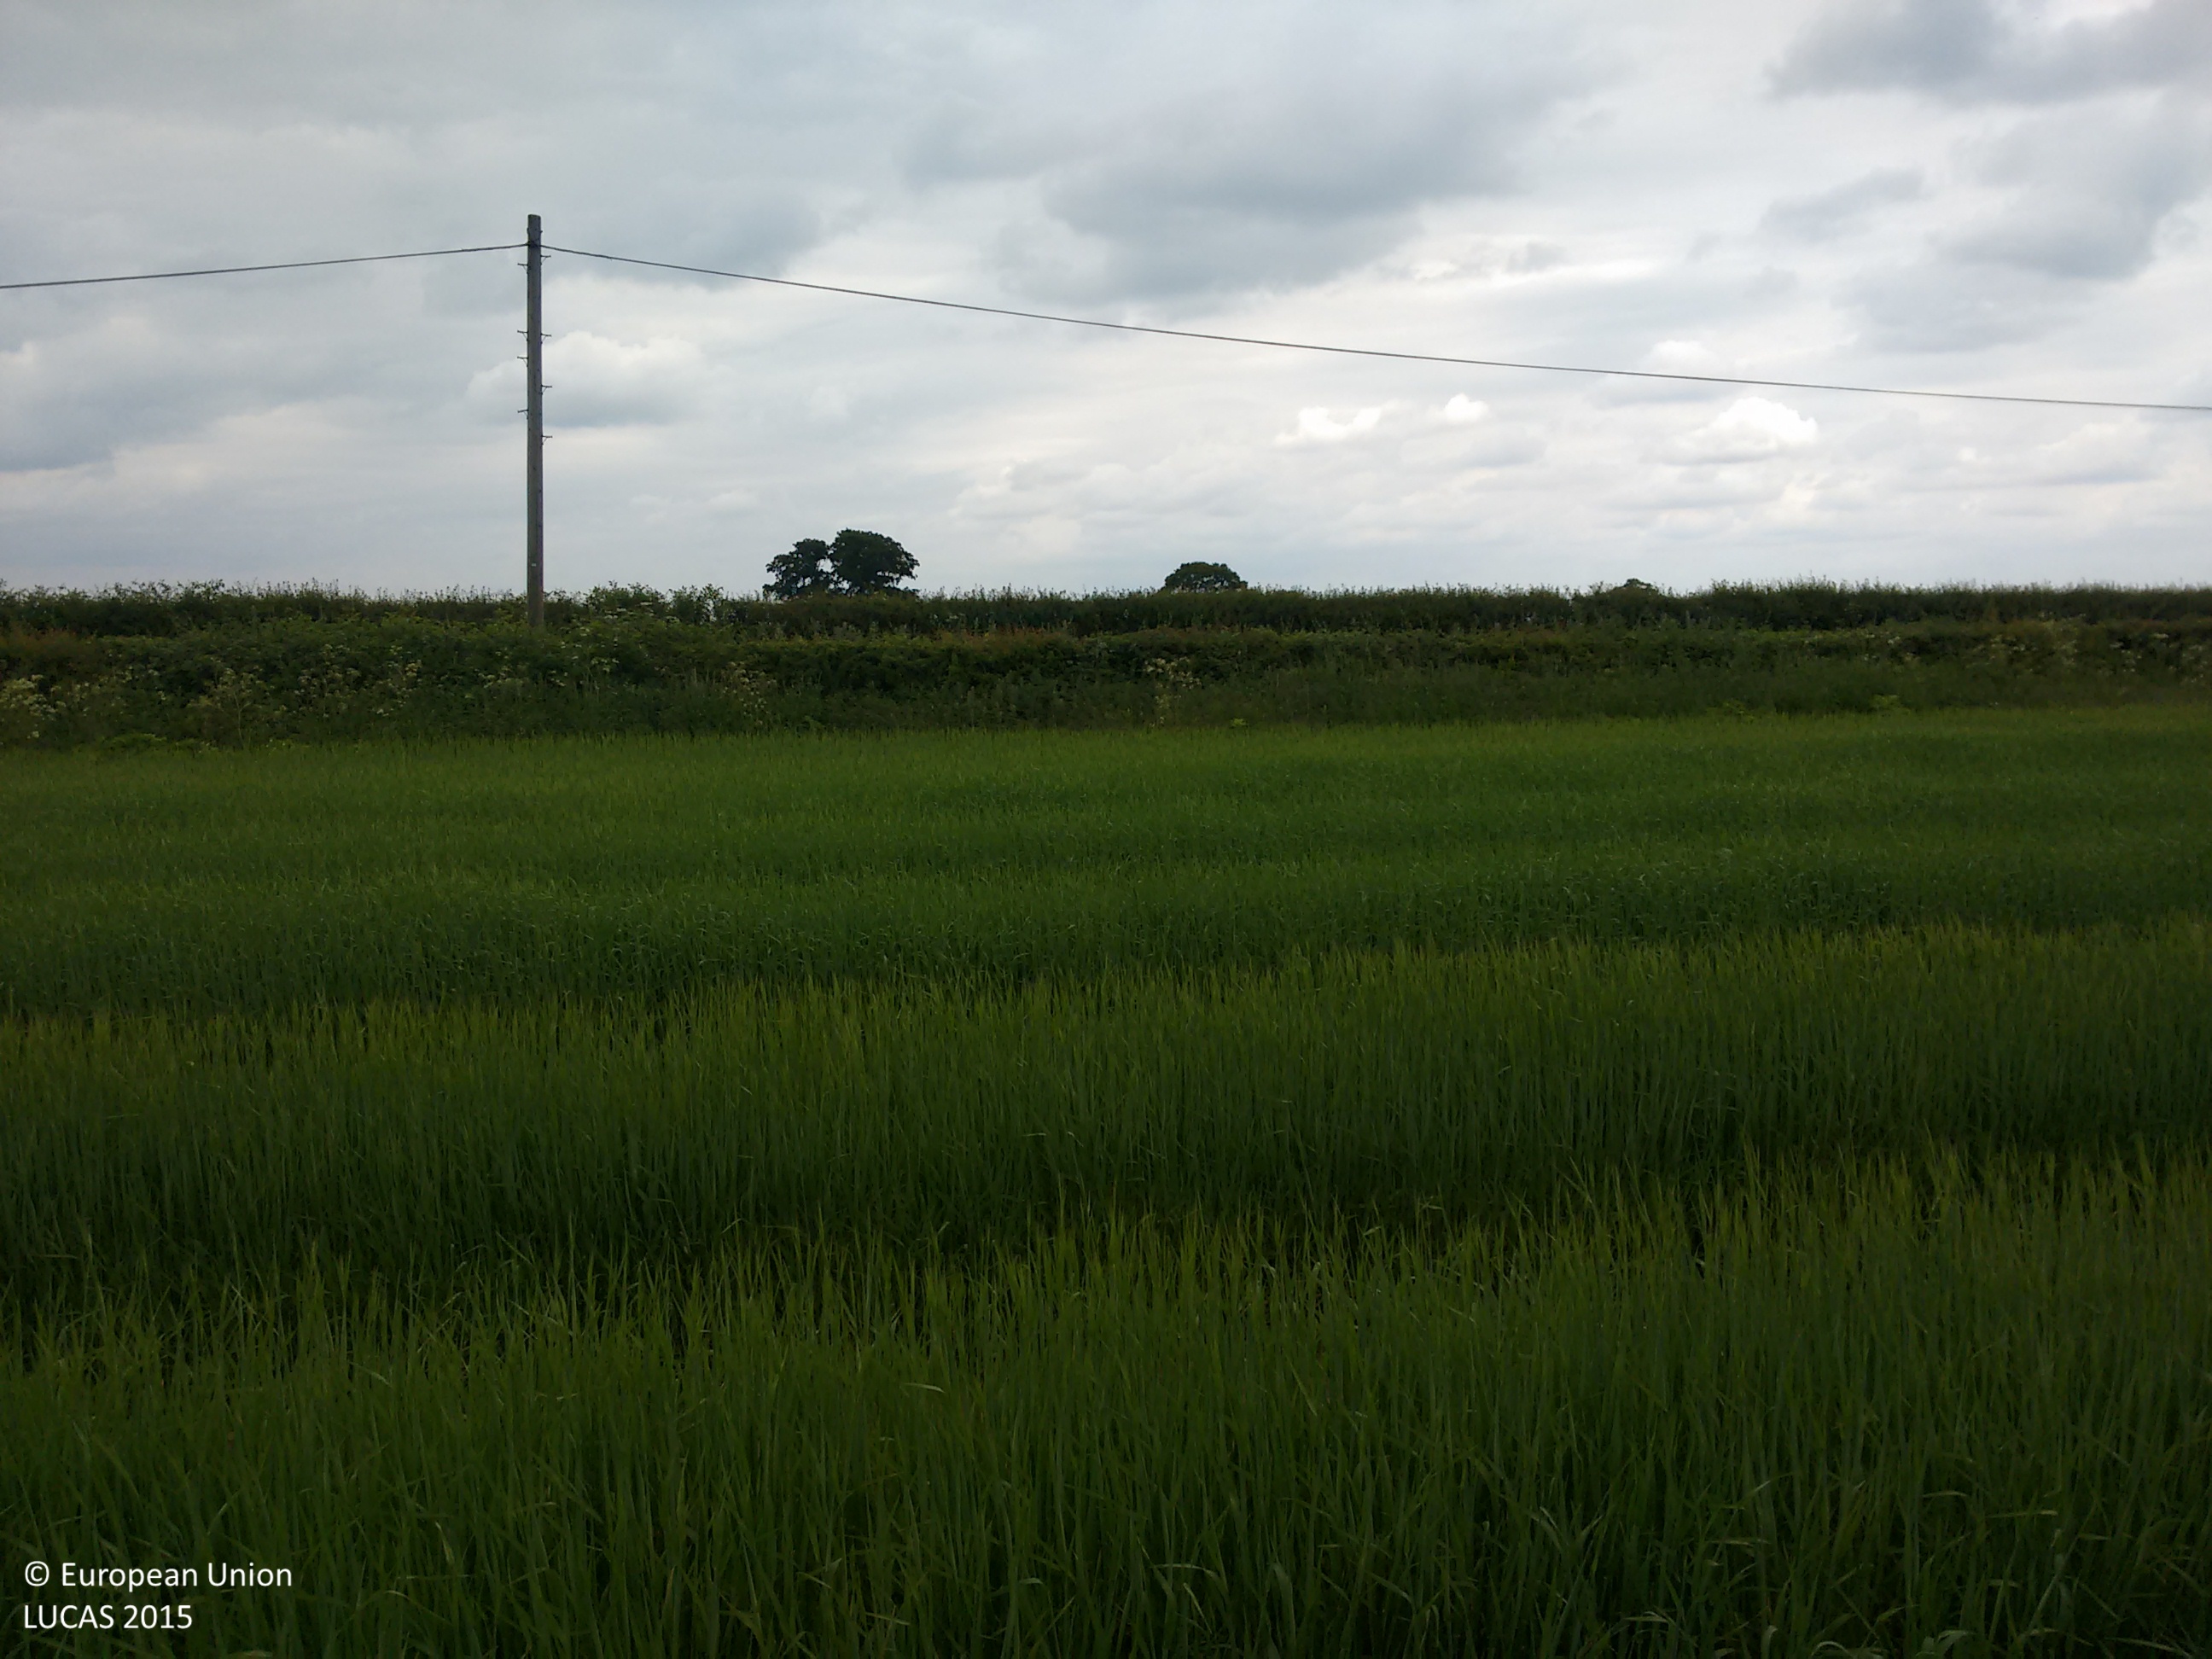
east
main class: Cropland
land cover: Barley
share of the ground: > 75 %
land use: Agriculture (excluding fallow land and kitchen gardens)
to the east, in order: Barley; Managed hedges; Grass margins; Paved roads, cycling and walking lanes; Grass margins; Electric lines; Managed hedges; Grass margins; Sugar beet
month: June
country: GB
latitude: 54.1757
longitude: -0.9342
